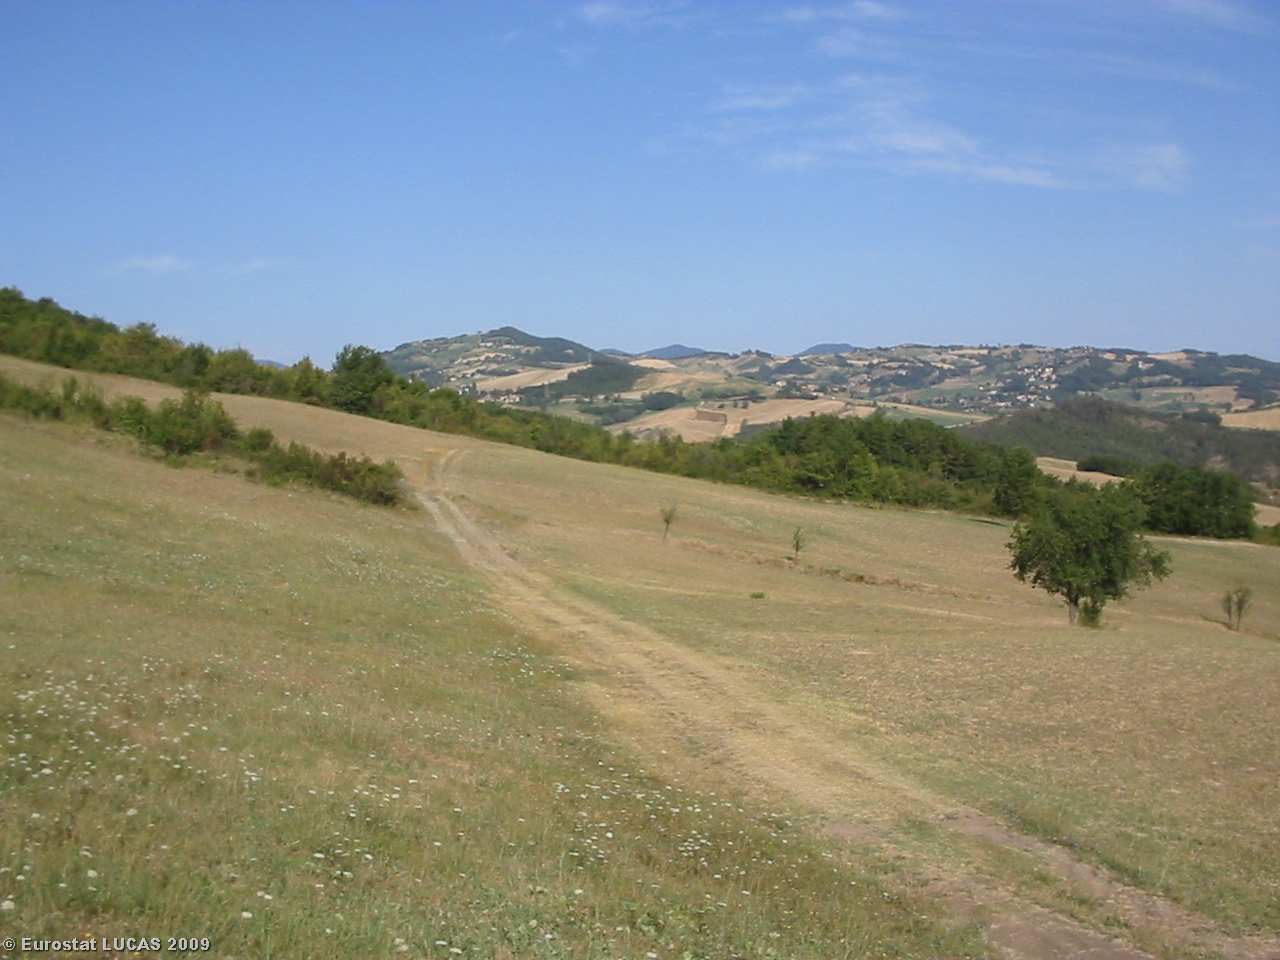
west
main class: Grassland
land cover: Grassland without tree/shrub cover
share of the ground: > 75 %
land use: Agriculture (excluding fallow land and kitchen gardens)
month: July
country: IT
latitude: 44.5484
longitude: 10.3391
